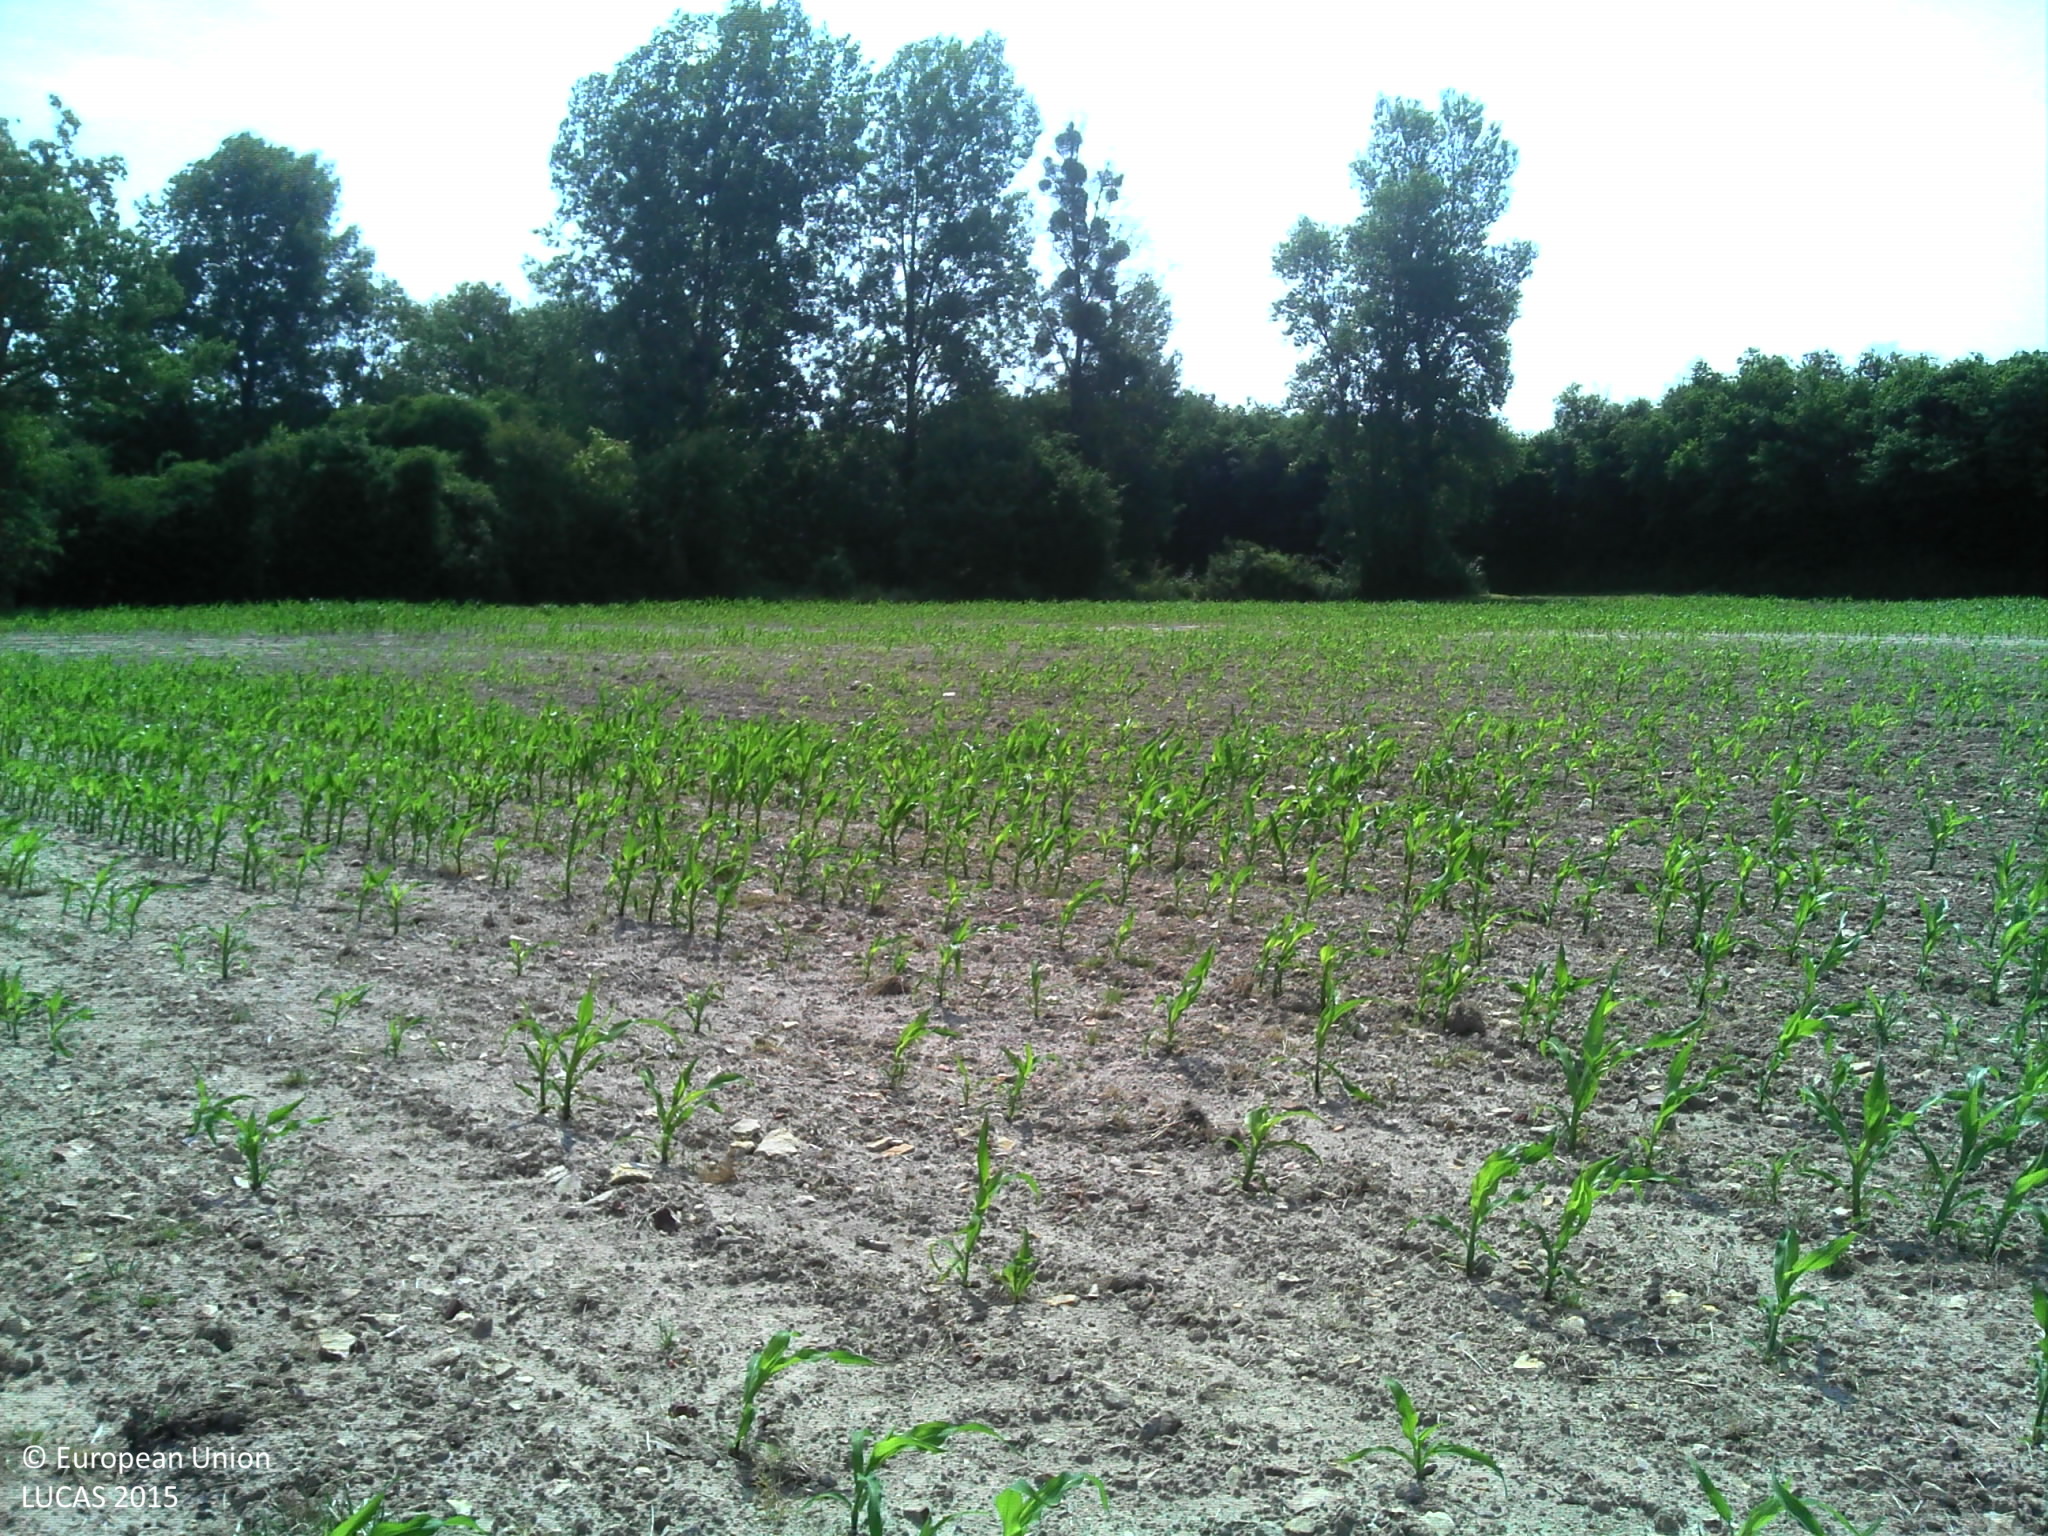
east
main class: Cropland
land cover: Maize
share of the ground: 10 - 25 %
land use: Agriculture (excluding fallow land and kitchen gardens)
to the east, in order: Maize; Grassland without tree/shrub cover; Rivers and streams; Lines of trees; Grassland without tree/shrub cover; Groves; Maize
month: June
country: FR
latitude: 47.5950
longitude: 0.0933
